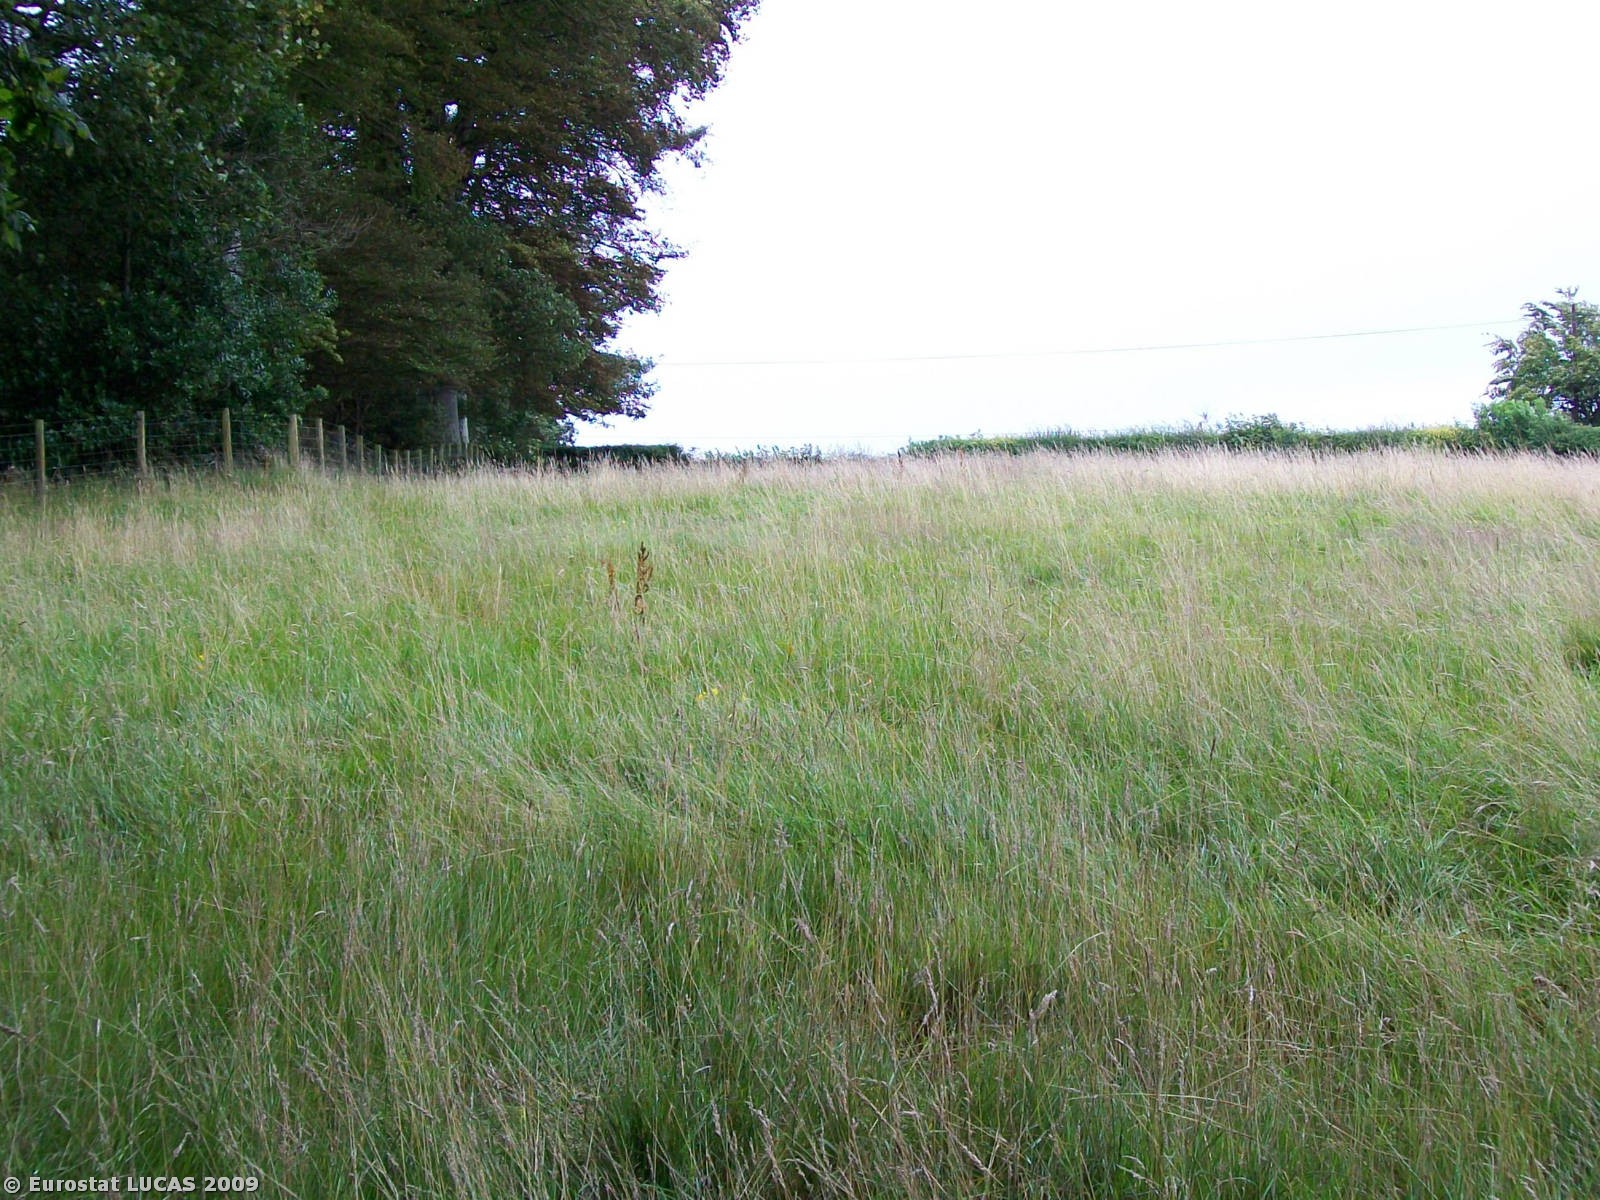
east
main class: Grassland
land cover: Grassland without tree/shrub cover
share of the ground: > 75 %
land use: Agriculture (excluding fallow land and kitchen gardens)
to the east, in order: Grassland without tree/shrub cover; Fences; Managed hedges; Artificial constructions in urban areas; Grass margins; Electric lines; Managed hedges; Grassland without tree/shrub cover; Electric lines; Grassland without tree/shrub cover; Abandoned hedges; Fences; Grassland without tree/shrub cover
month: July
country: GB
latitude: 55.0034
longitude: -3.2556
